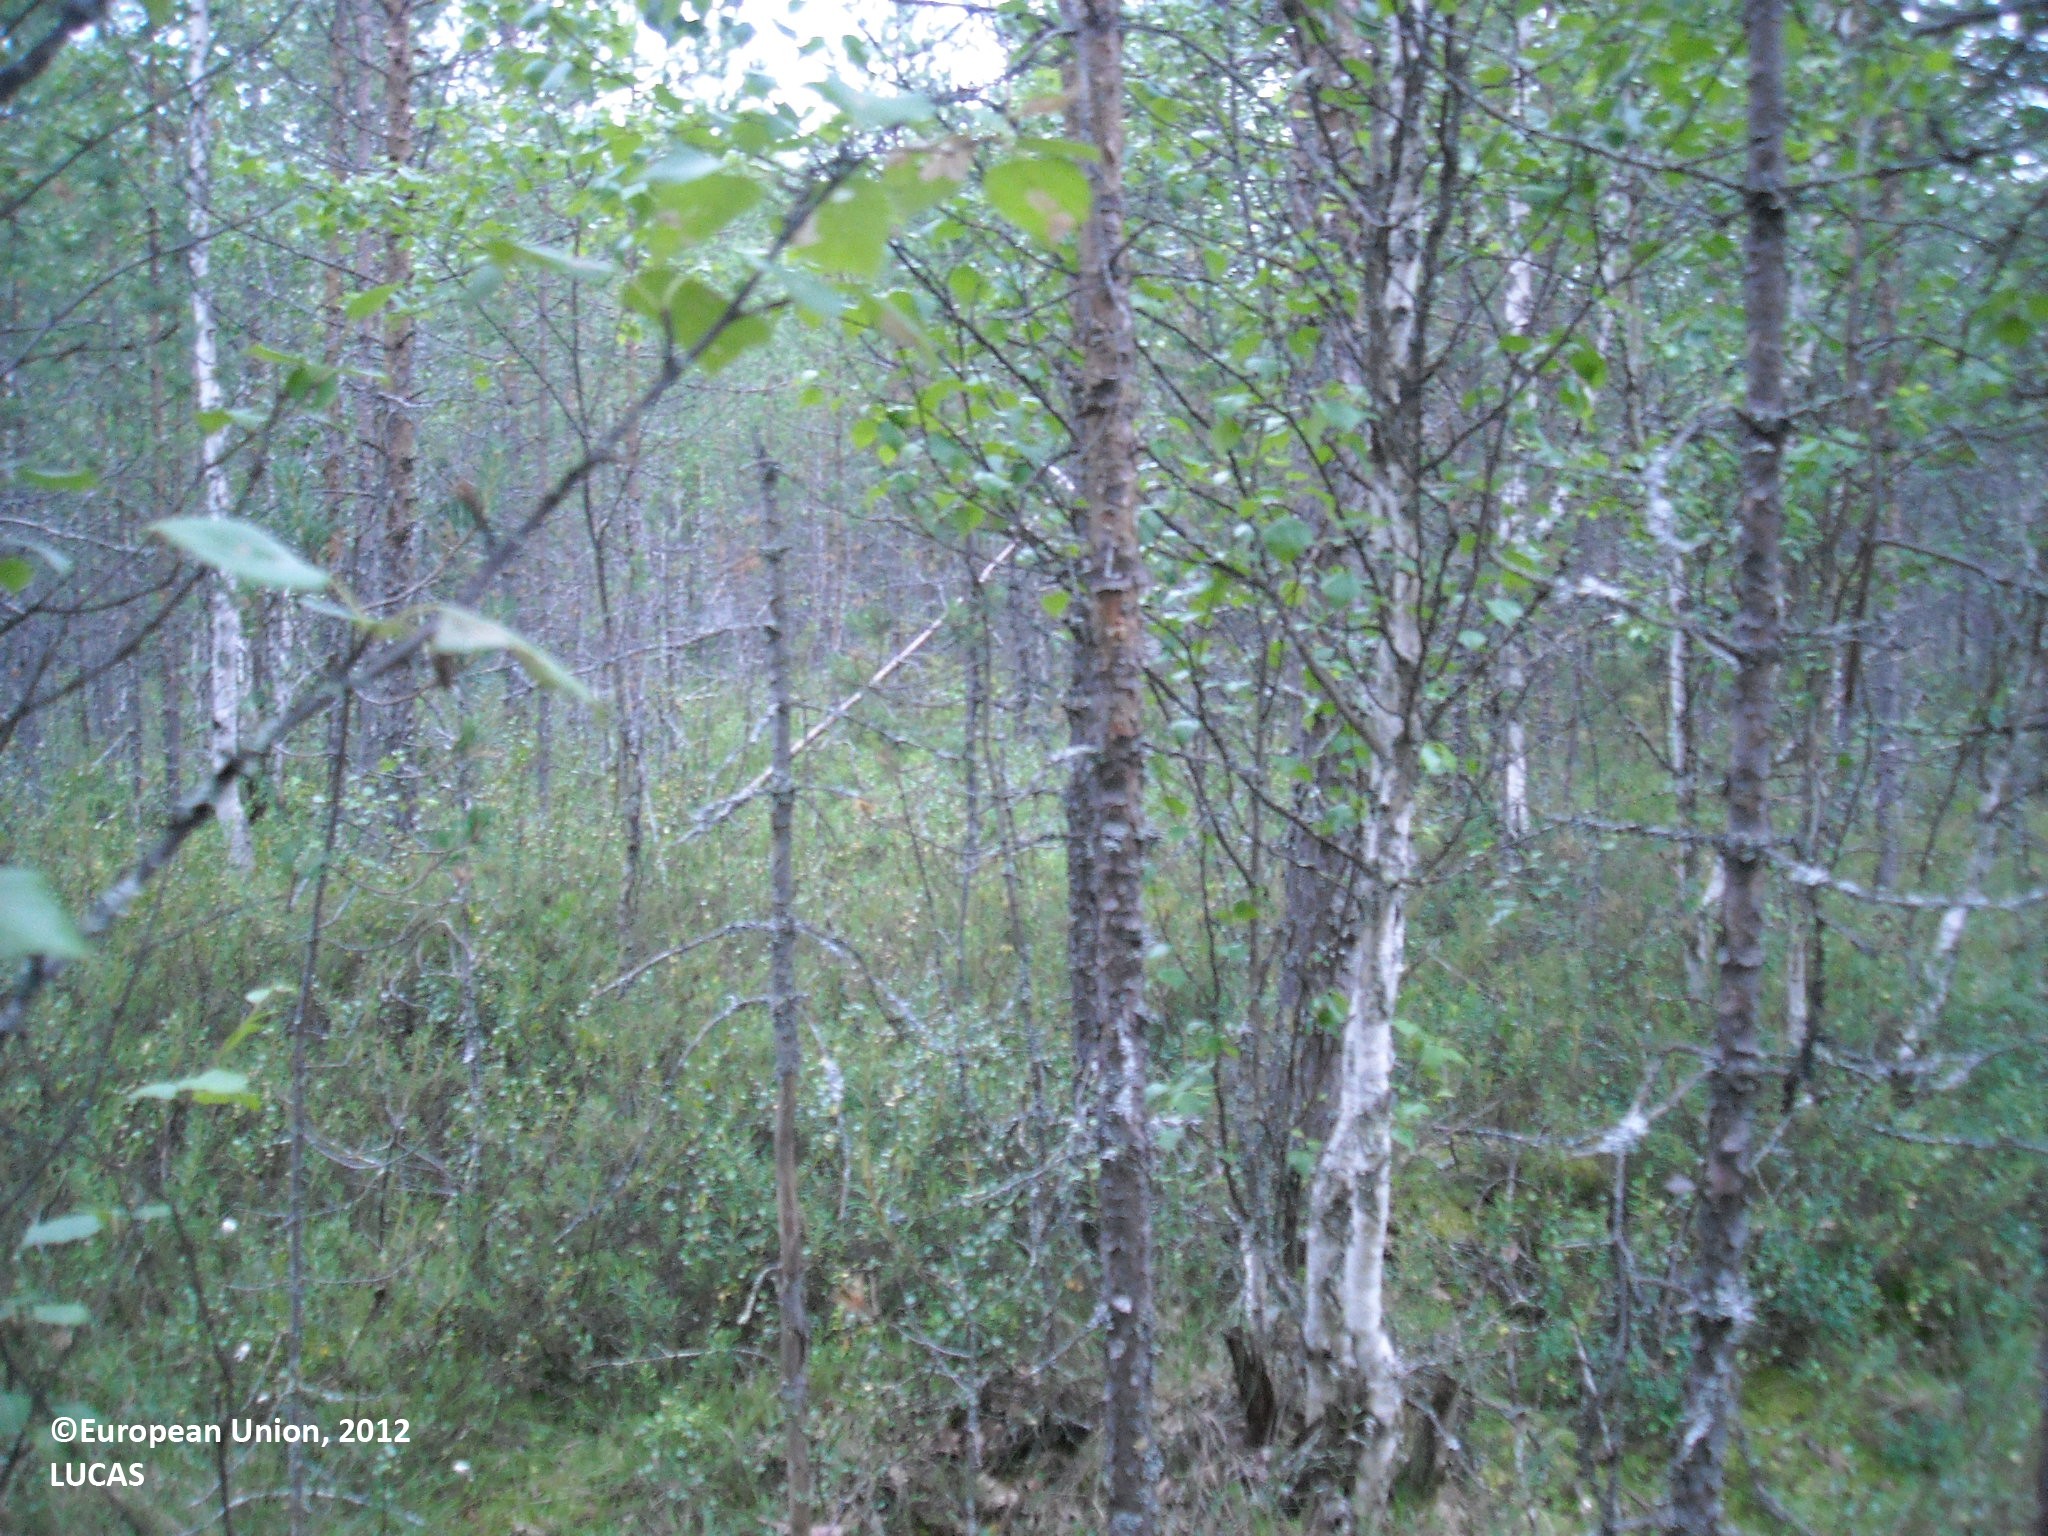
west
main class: Woodland
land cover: Pine dominated mixed woodland
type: mire and swamp forests
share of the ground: > 75 %
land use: Forestry
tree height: > 5 m
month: July
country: FI
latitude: 64.9179
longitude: 26.8415
